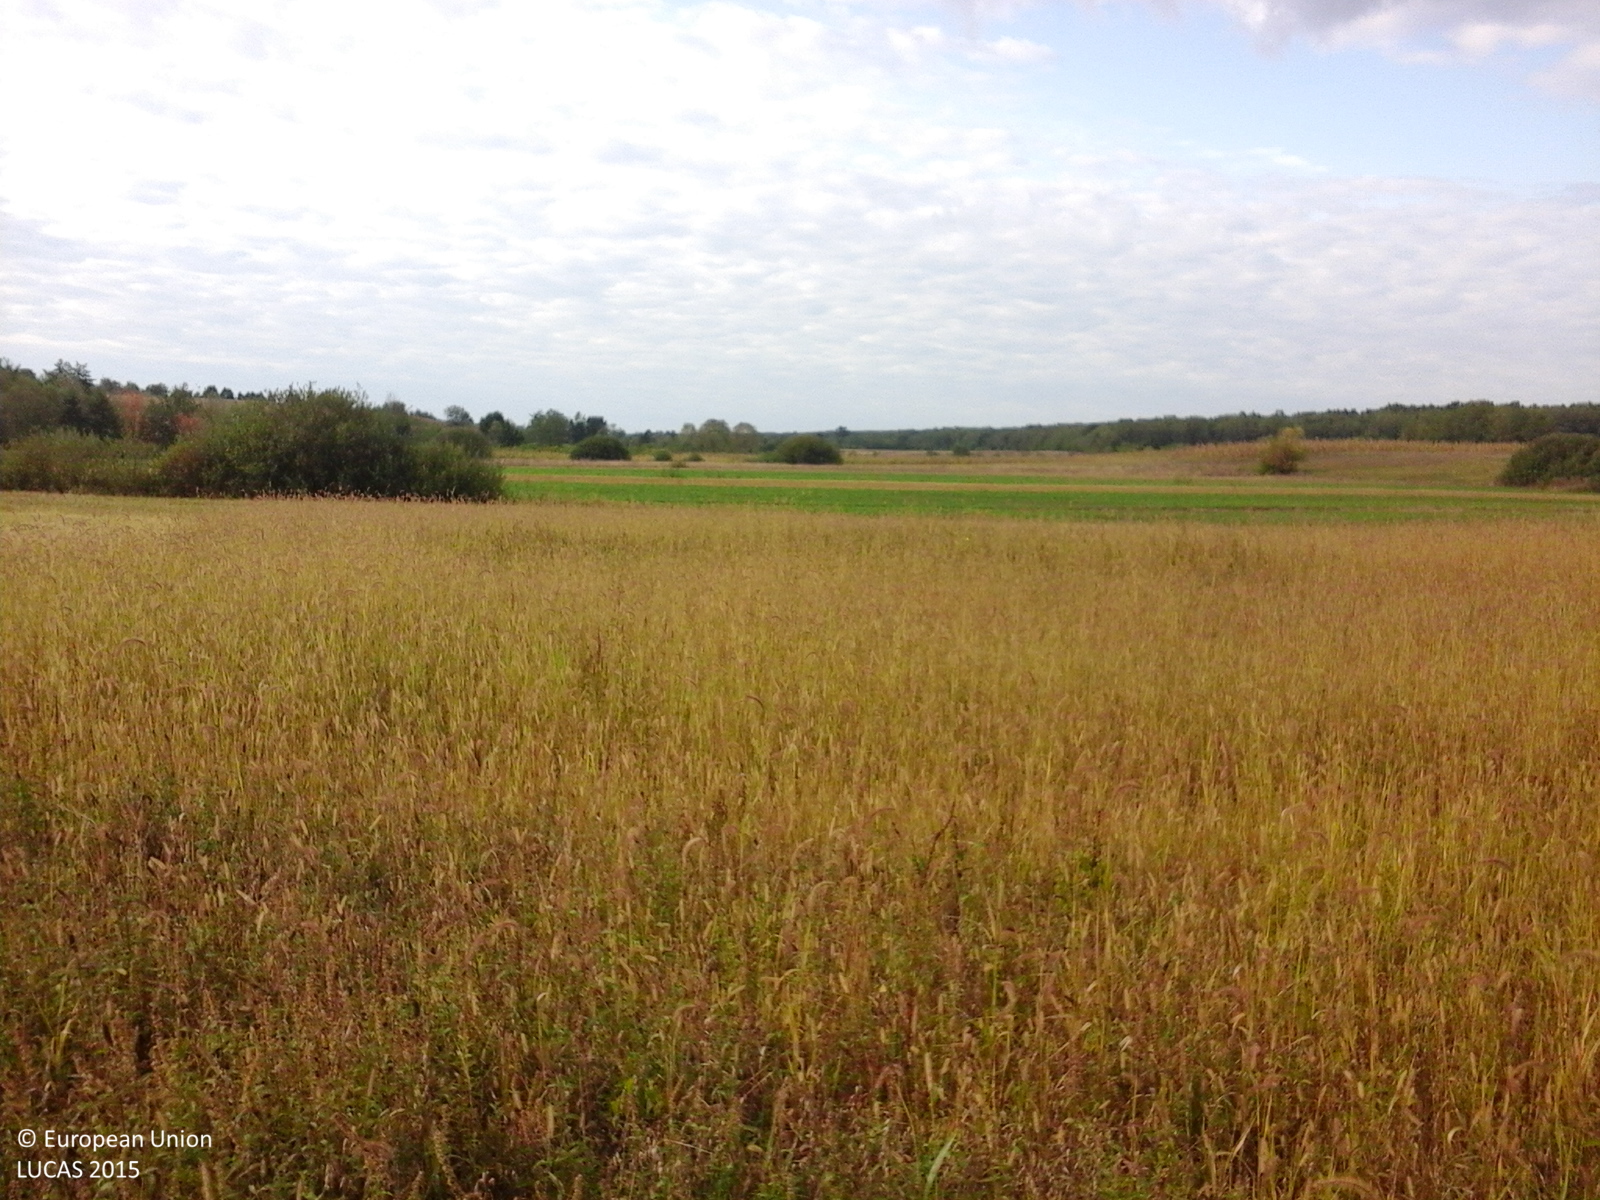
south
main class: Grassland
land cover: Grassland without tree/shrub cover
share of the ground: > 75 %
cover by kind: herbaceous plants 100 %
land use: Agriculture (excluding fallow land and kitchen gardens)
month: September
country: RO
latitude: 47.5934
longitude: 23.4656
